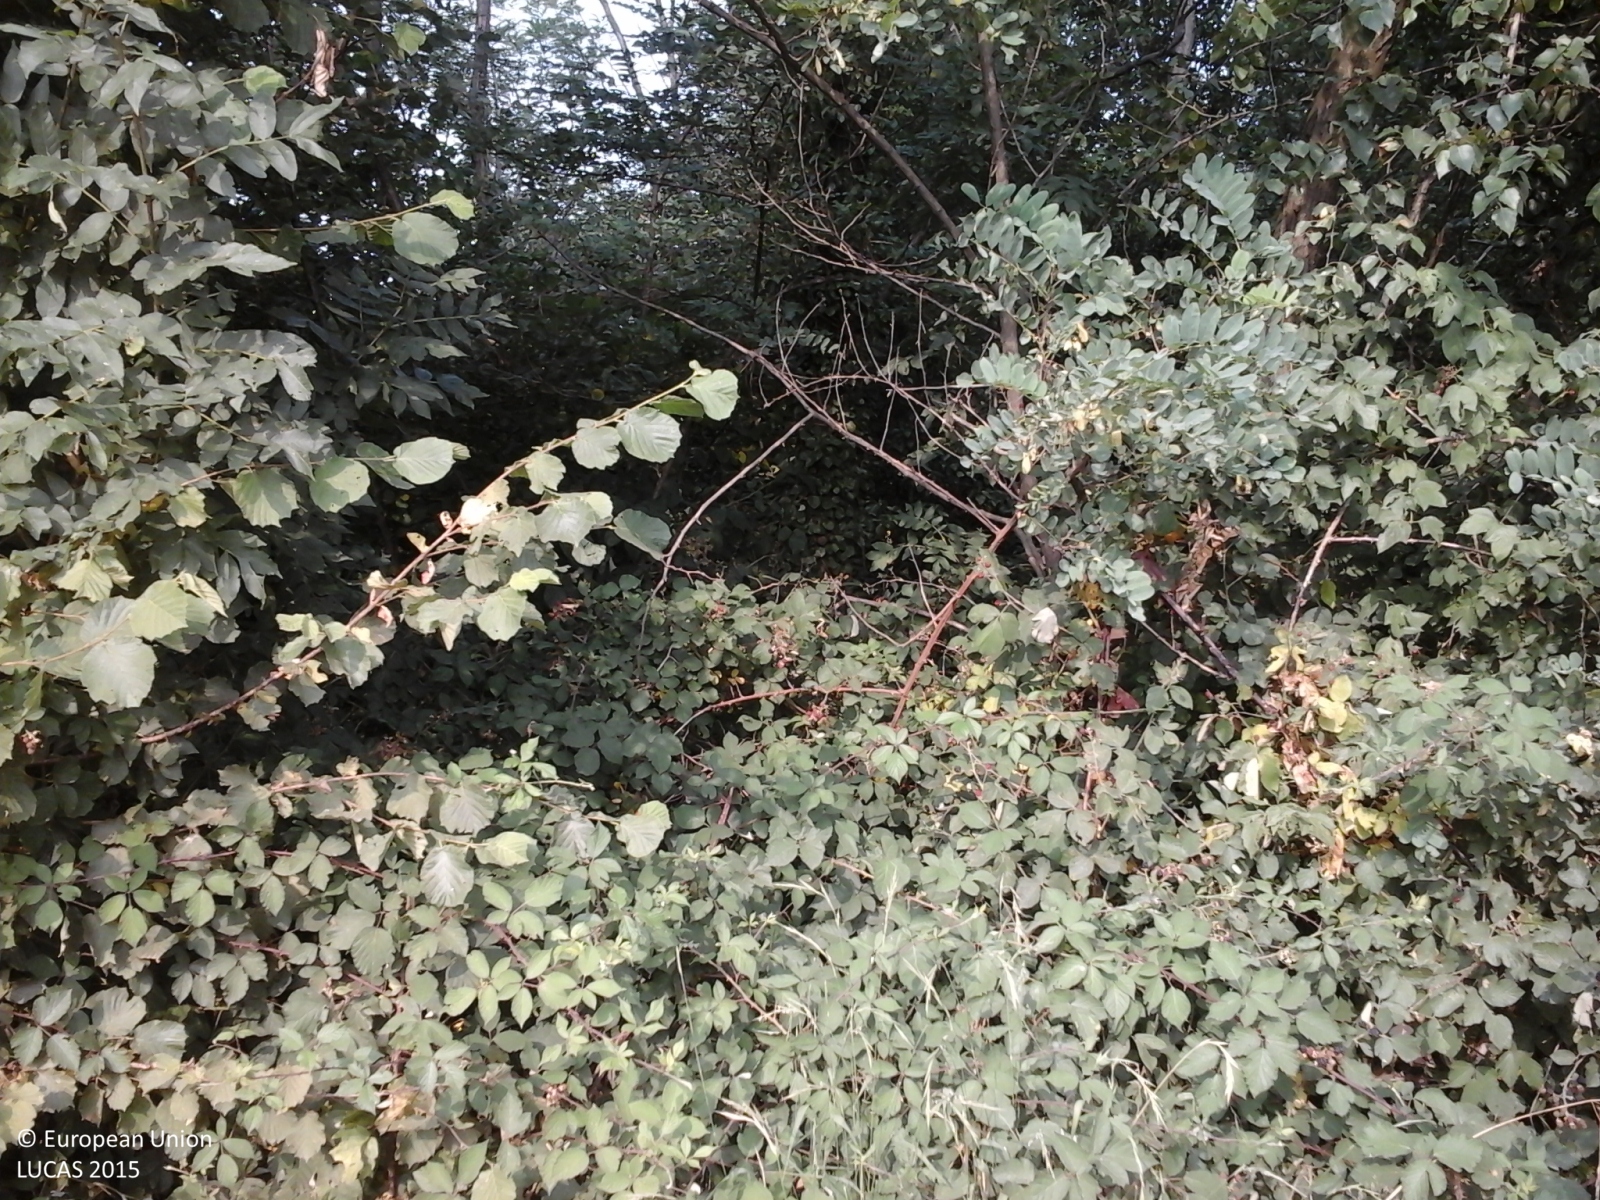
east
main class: Woodland
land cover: Broadleaved woodland
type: thermophilous deciduous forest
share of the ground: > 75 %
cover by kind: broadleaved forest trees 100 %
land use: Semi-natural and natural areas not in use
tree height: > 5 m
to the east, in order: Broadleaved woodland
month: July
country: IT
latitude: 45.2967
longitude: 7.5938
